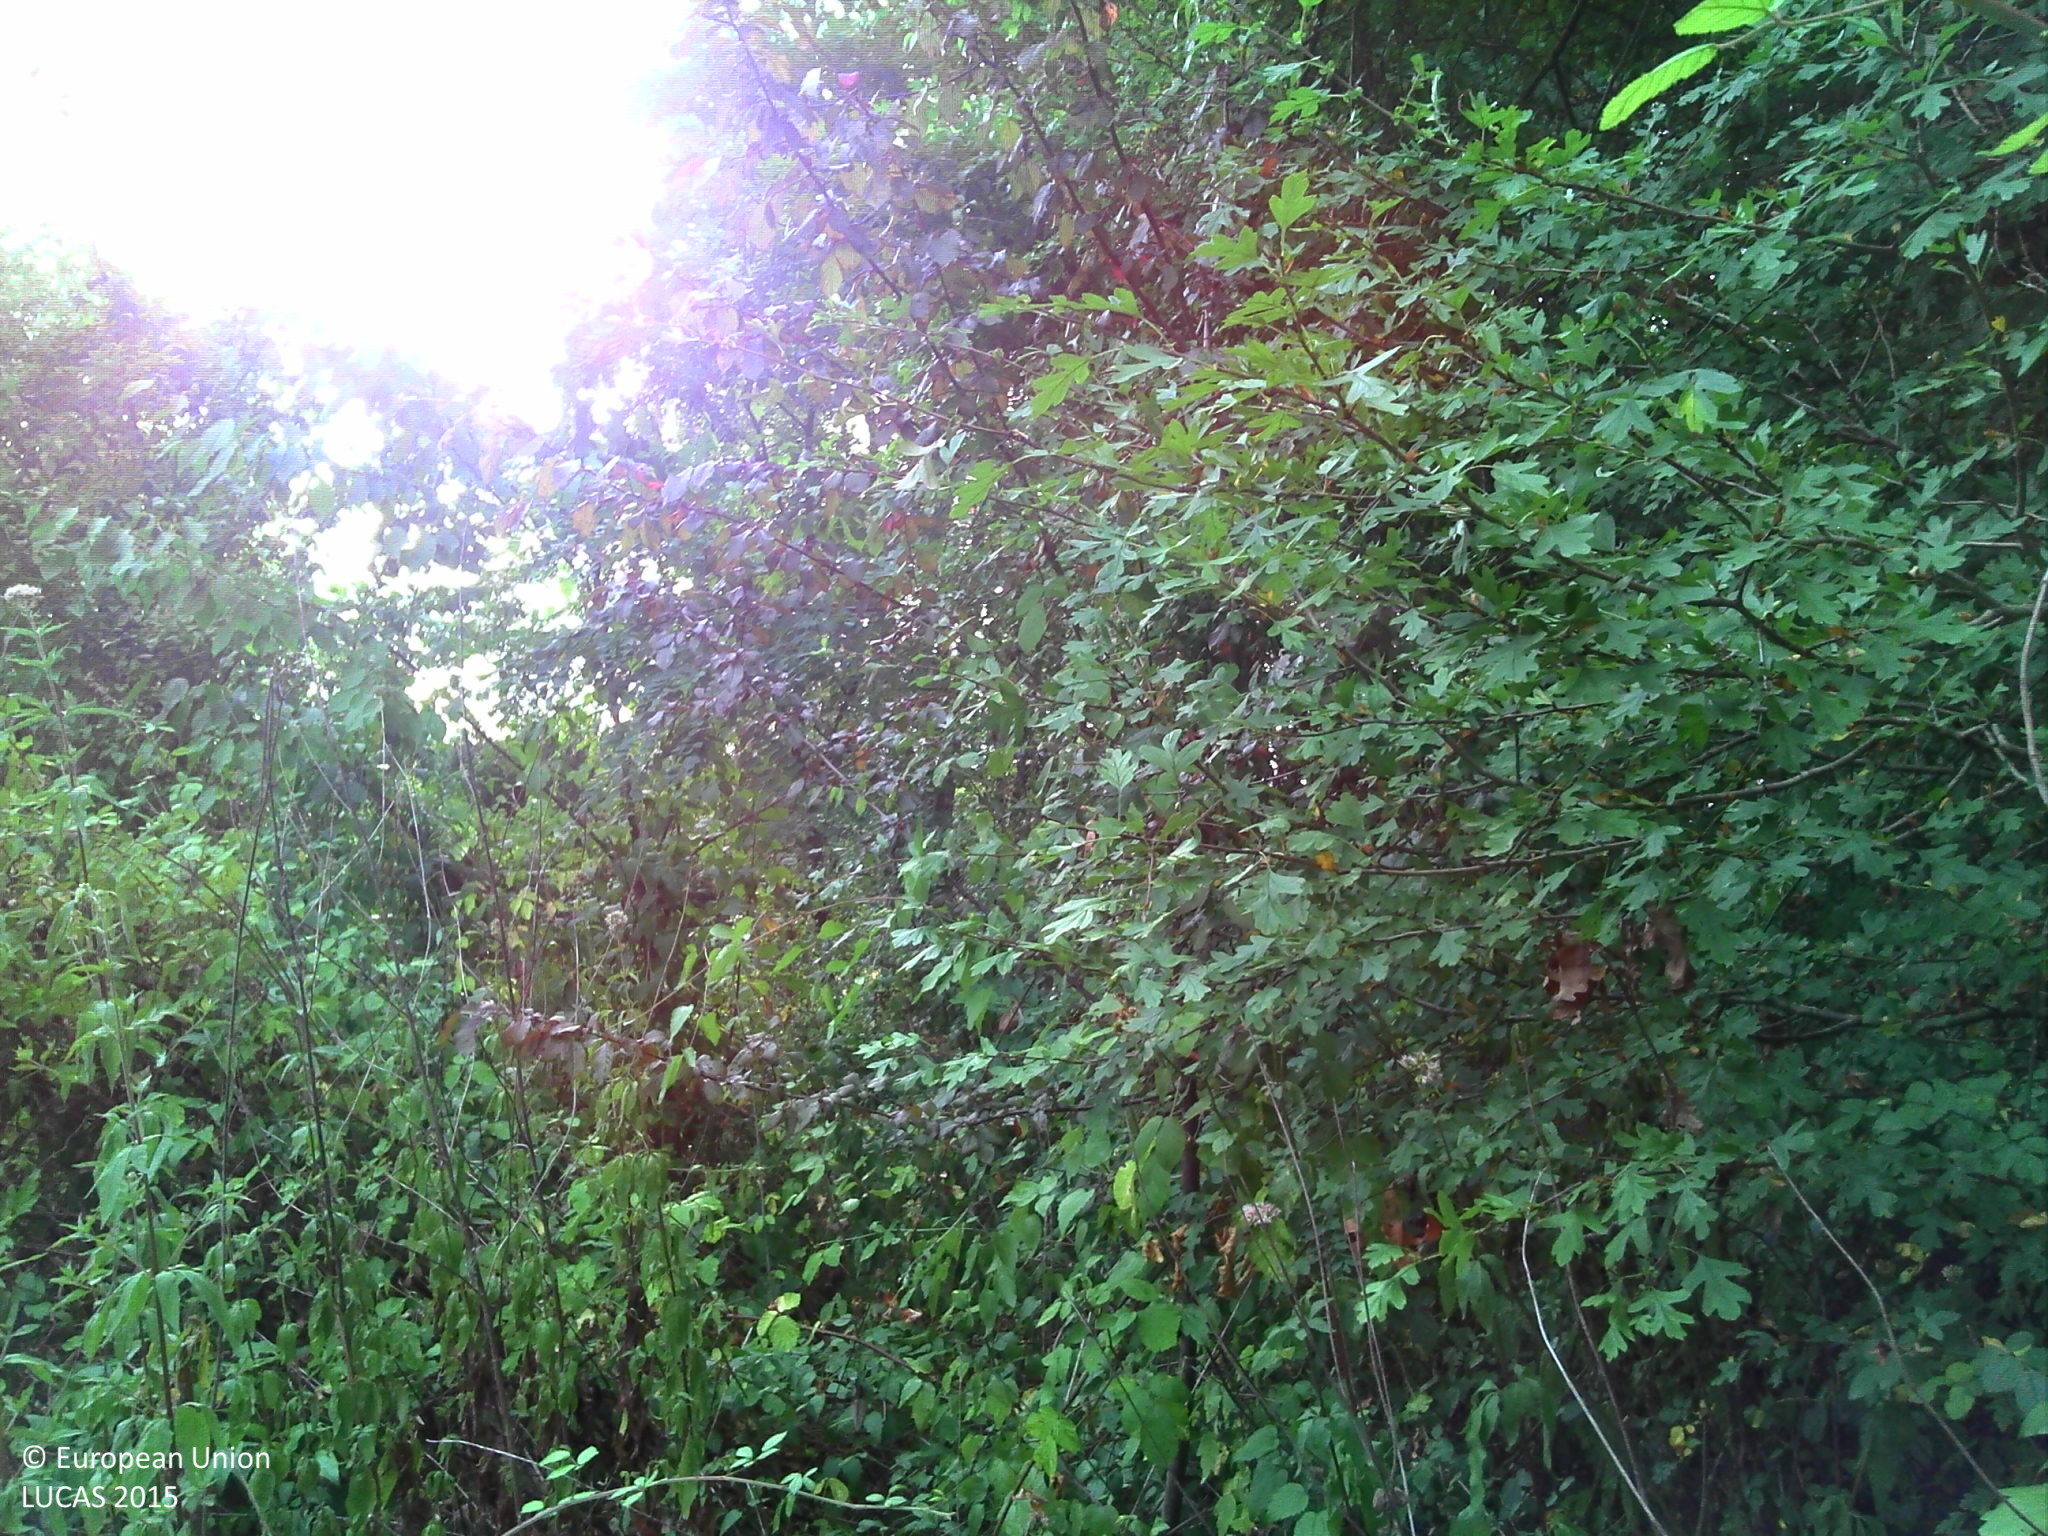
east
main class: Woodland
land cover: Broadleaved woodland
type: thermophilous deciduous forest
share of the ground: > 75 %
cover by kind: broadleaved forest trees 80 %, herbaceous plants 10 %, shrubs 5 %, lichens and mosses 5 %
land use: Residential
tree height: > 5 m
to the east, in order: Broadleaved woodland; Fences; Grassland without tree/shrub cover; Grassland with sparse tree/shrub cover; Fences; Grassland without tree/shrub cover; Broadleaved woodland
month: July
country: FR
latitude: 44.9570
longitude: 0.8014
